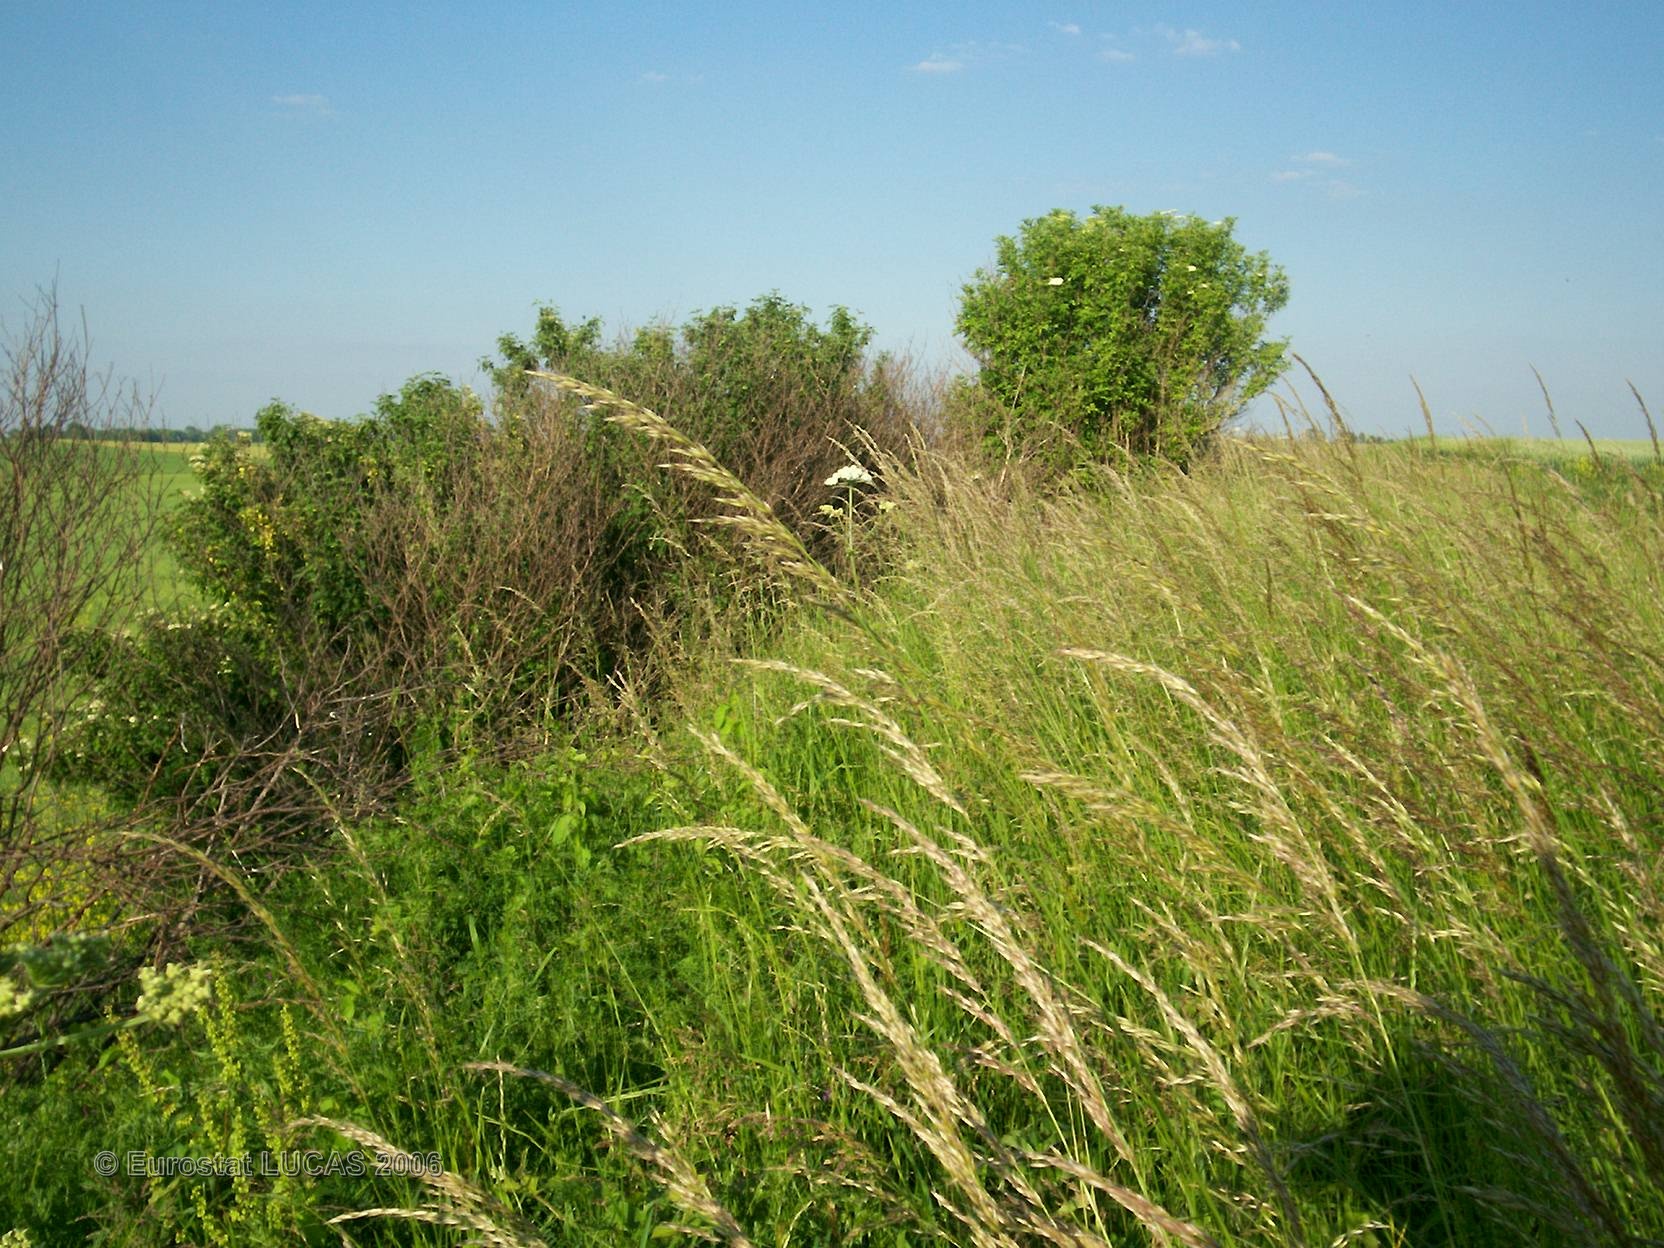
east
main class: Cropland
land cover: Rape and turnip rape
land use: Agriculture (excluding fallow land and kitchen gardens)
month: June
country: FR
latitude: 48.9313
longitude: 4.8242
